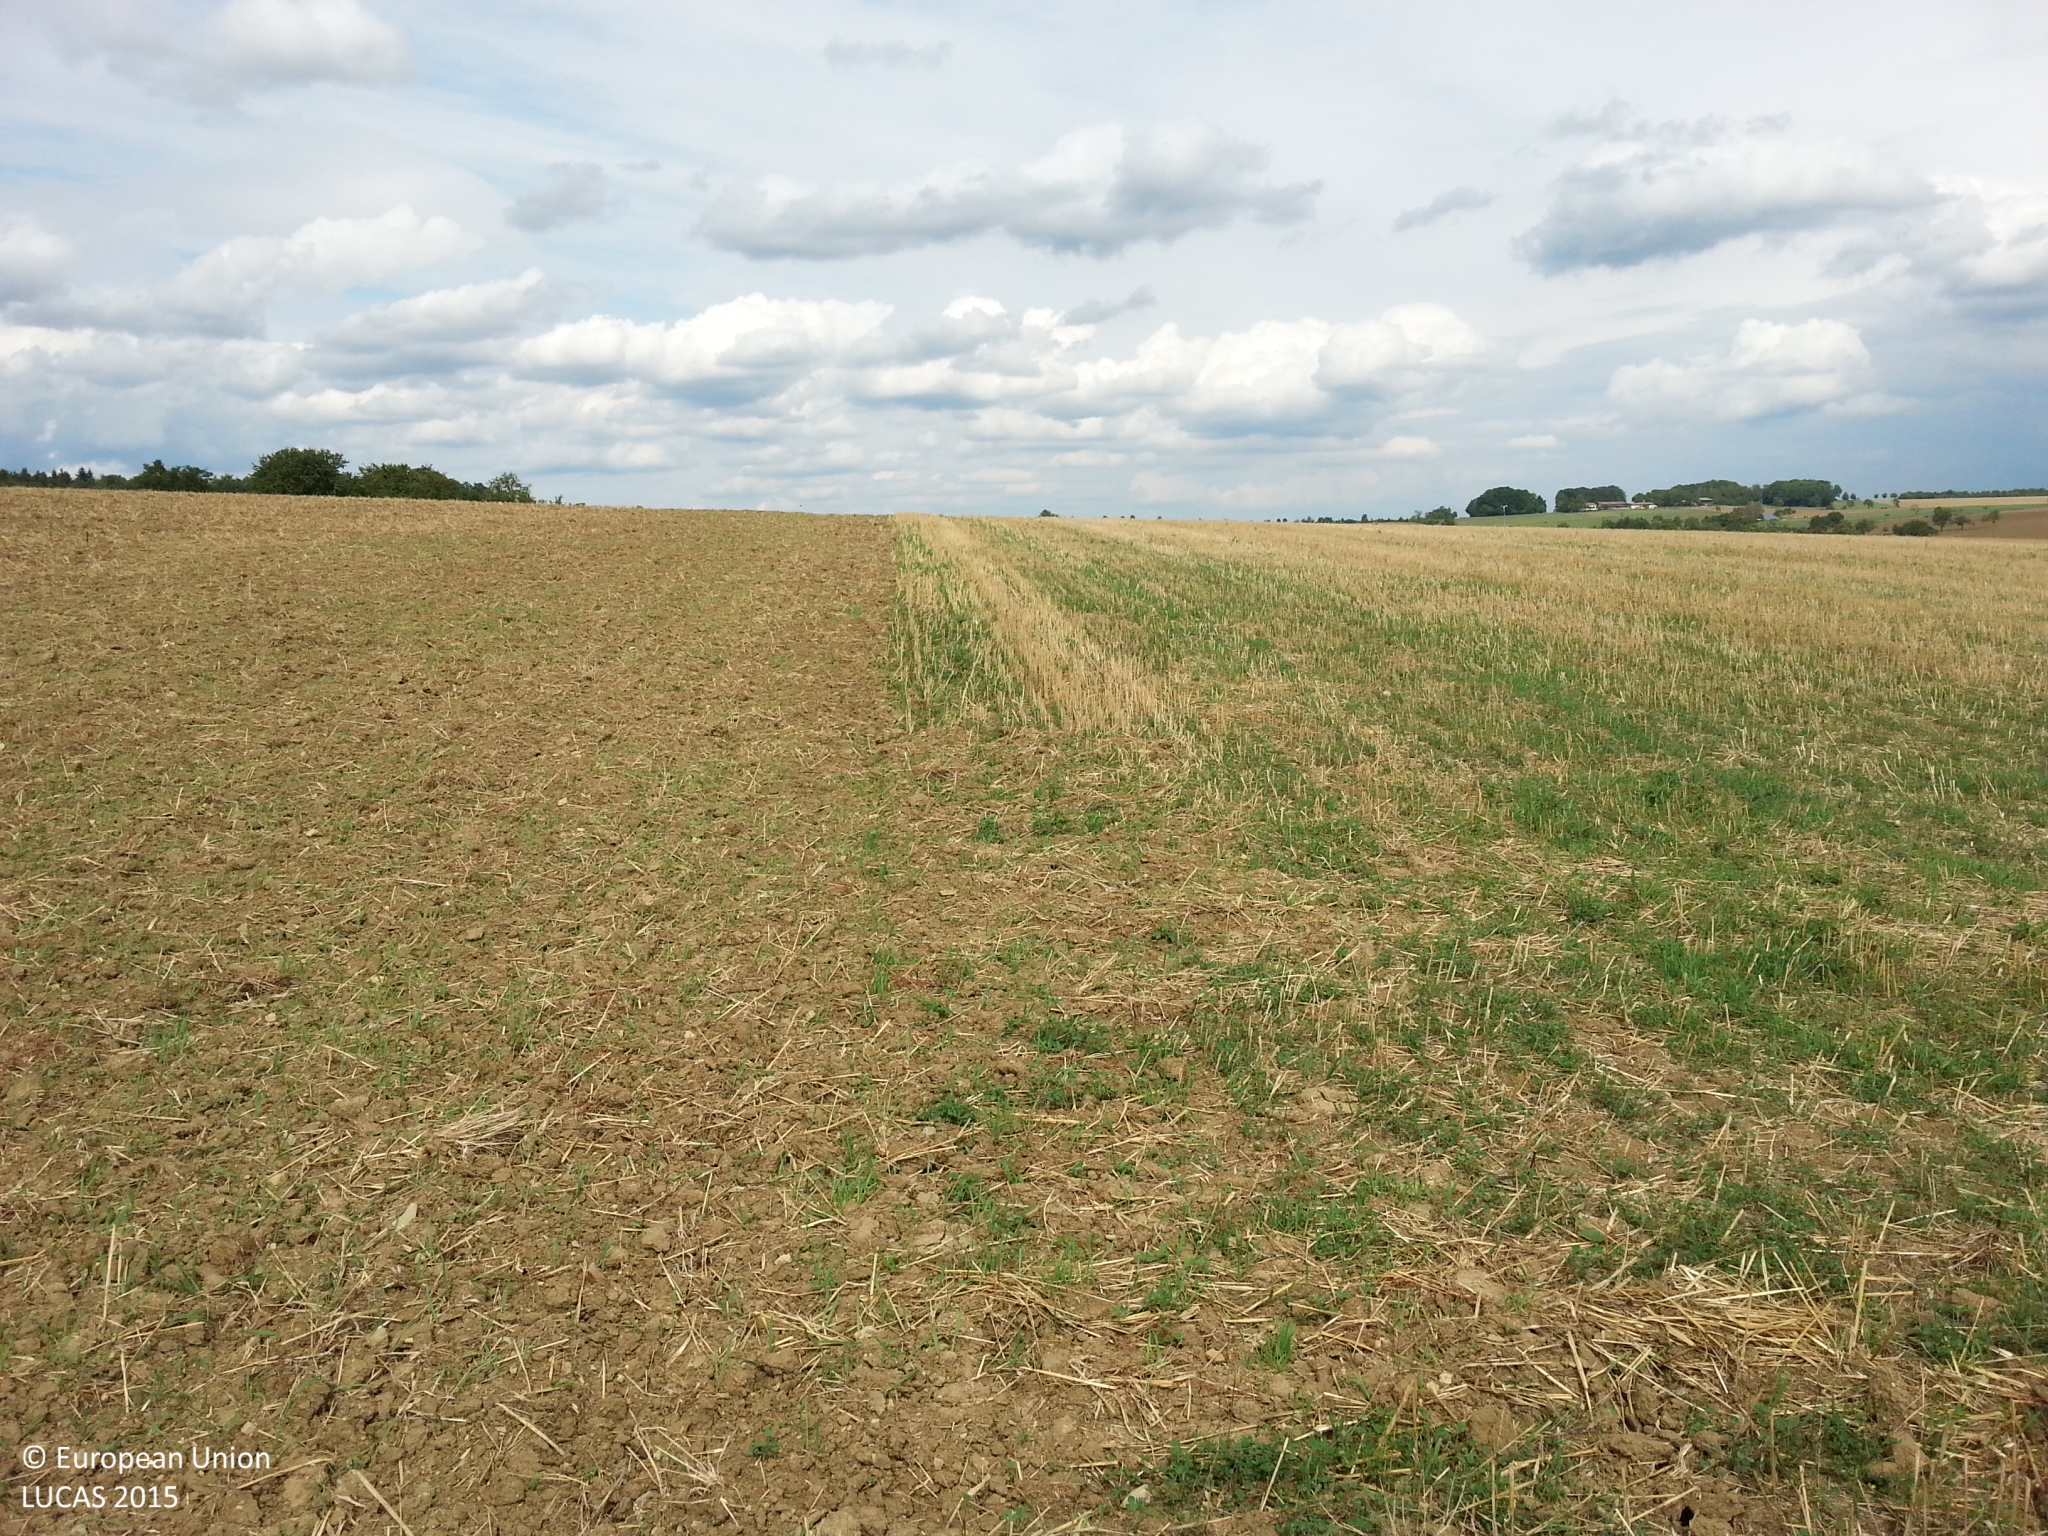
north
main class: Cropland
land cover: Common wheat
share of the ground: < 10 %
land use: Agriculture (excluding fallow land and kitchen gardens)
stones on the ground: < 10 %
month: September
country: DE
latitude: 49.4462
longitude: 9.6002
